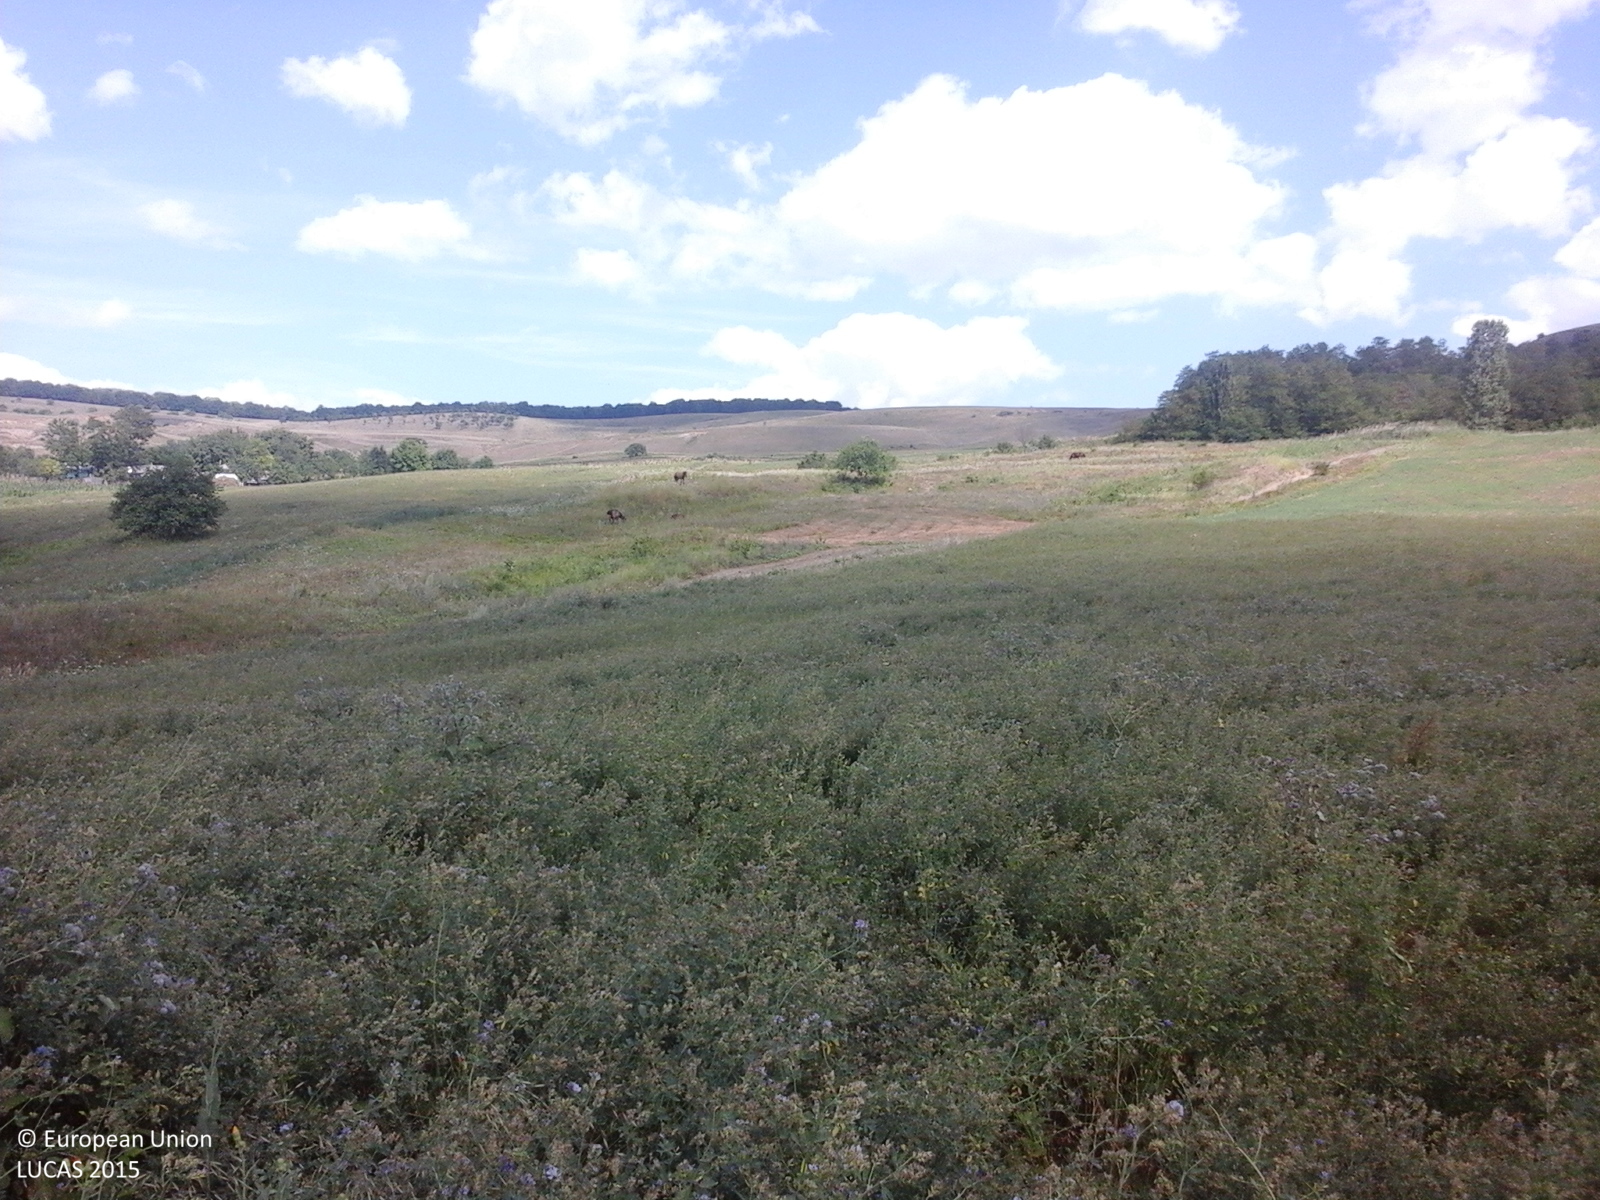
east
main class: Cropland
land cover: Lucerne
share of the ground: > 75 %
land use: Agriculture (excluding fallow land and kitchen gardens)
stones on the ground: < 10 %
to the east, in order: Lucerne; Shruby margins; Tracks; Shruby margins; Spontaneously vegetated surfaces; Lucerne
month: July
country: RO
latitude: 46.5859
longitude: 27.4007
